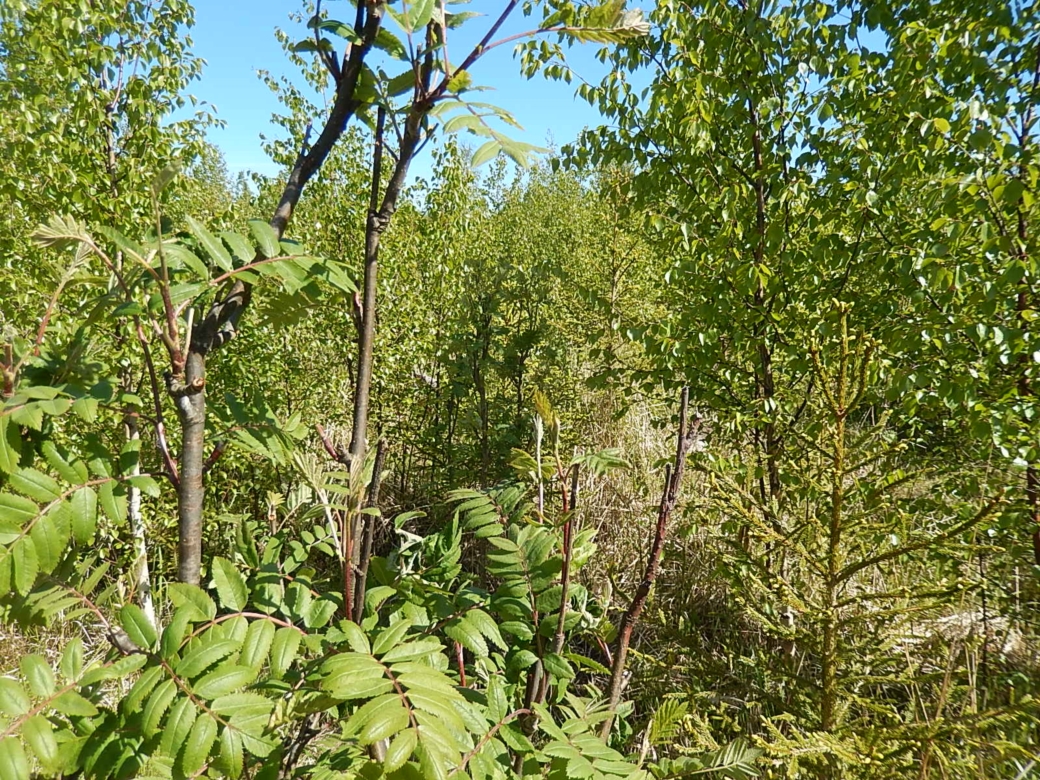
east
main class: Woodland
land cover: Other mixed woodland
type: boreal forest
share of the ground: 50 - 75 %
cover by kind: broadleaved forest trees 45 %, herbaceous plants 30 %, coniferous forest trees 25 %
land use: Forestry
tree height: < 5 m
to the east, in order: Other mixed woodland; Tracks; Ditches and canals; Other mixed woodland; Spruce dominated coniferous woodland; Ditches and canals; Other coniferous woodland
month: June
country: FI
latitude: 62.0100
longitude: 21.4491
